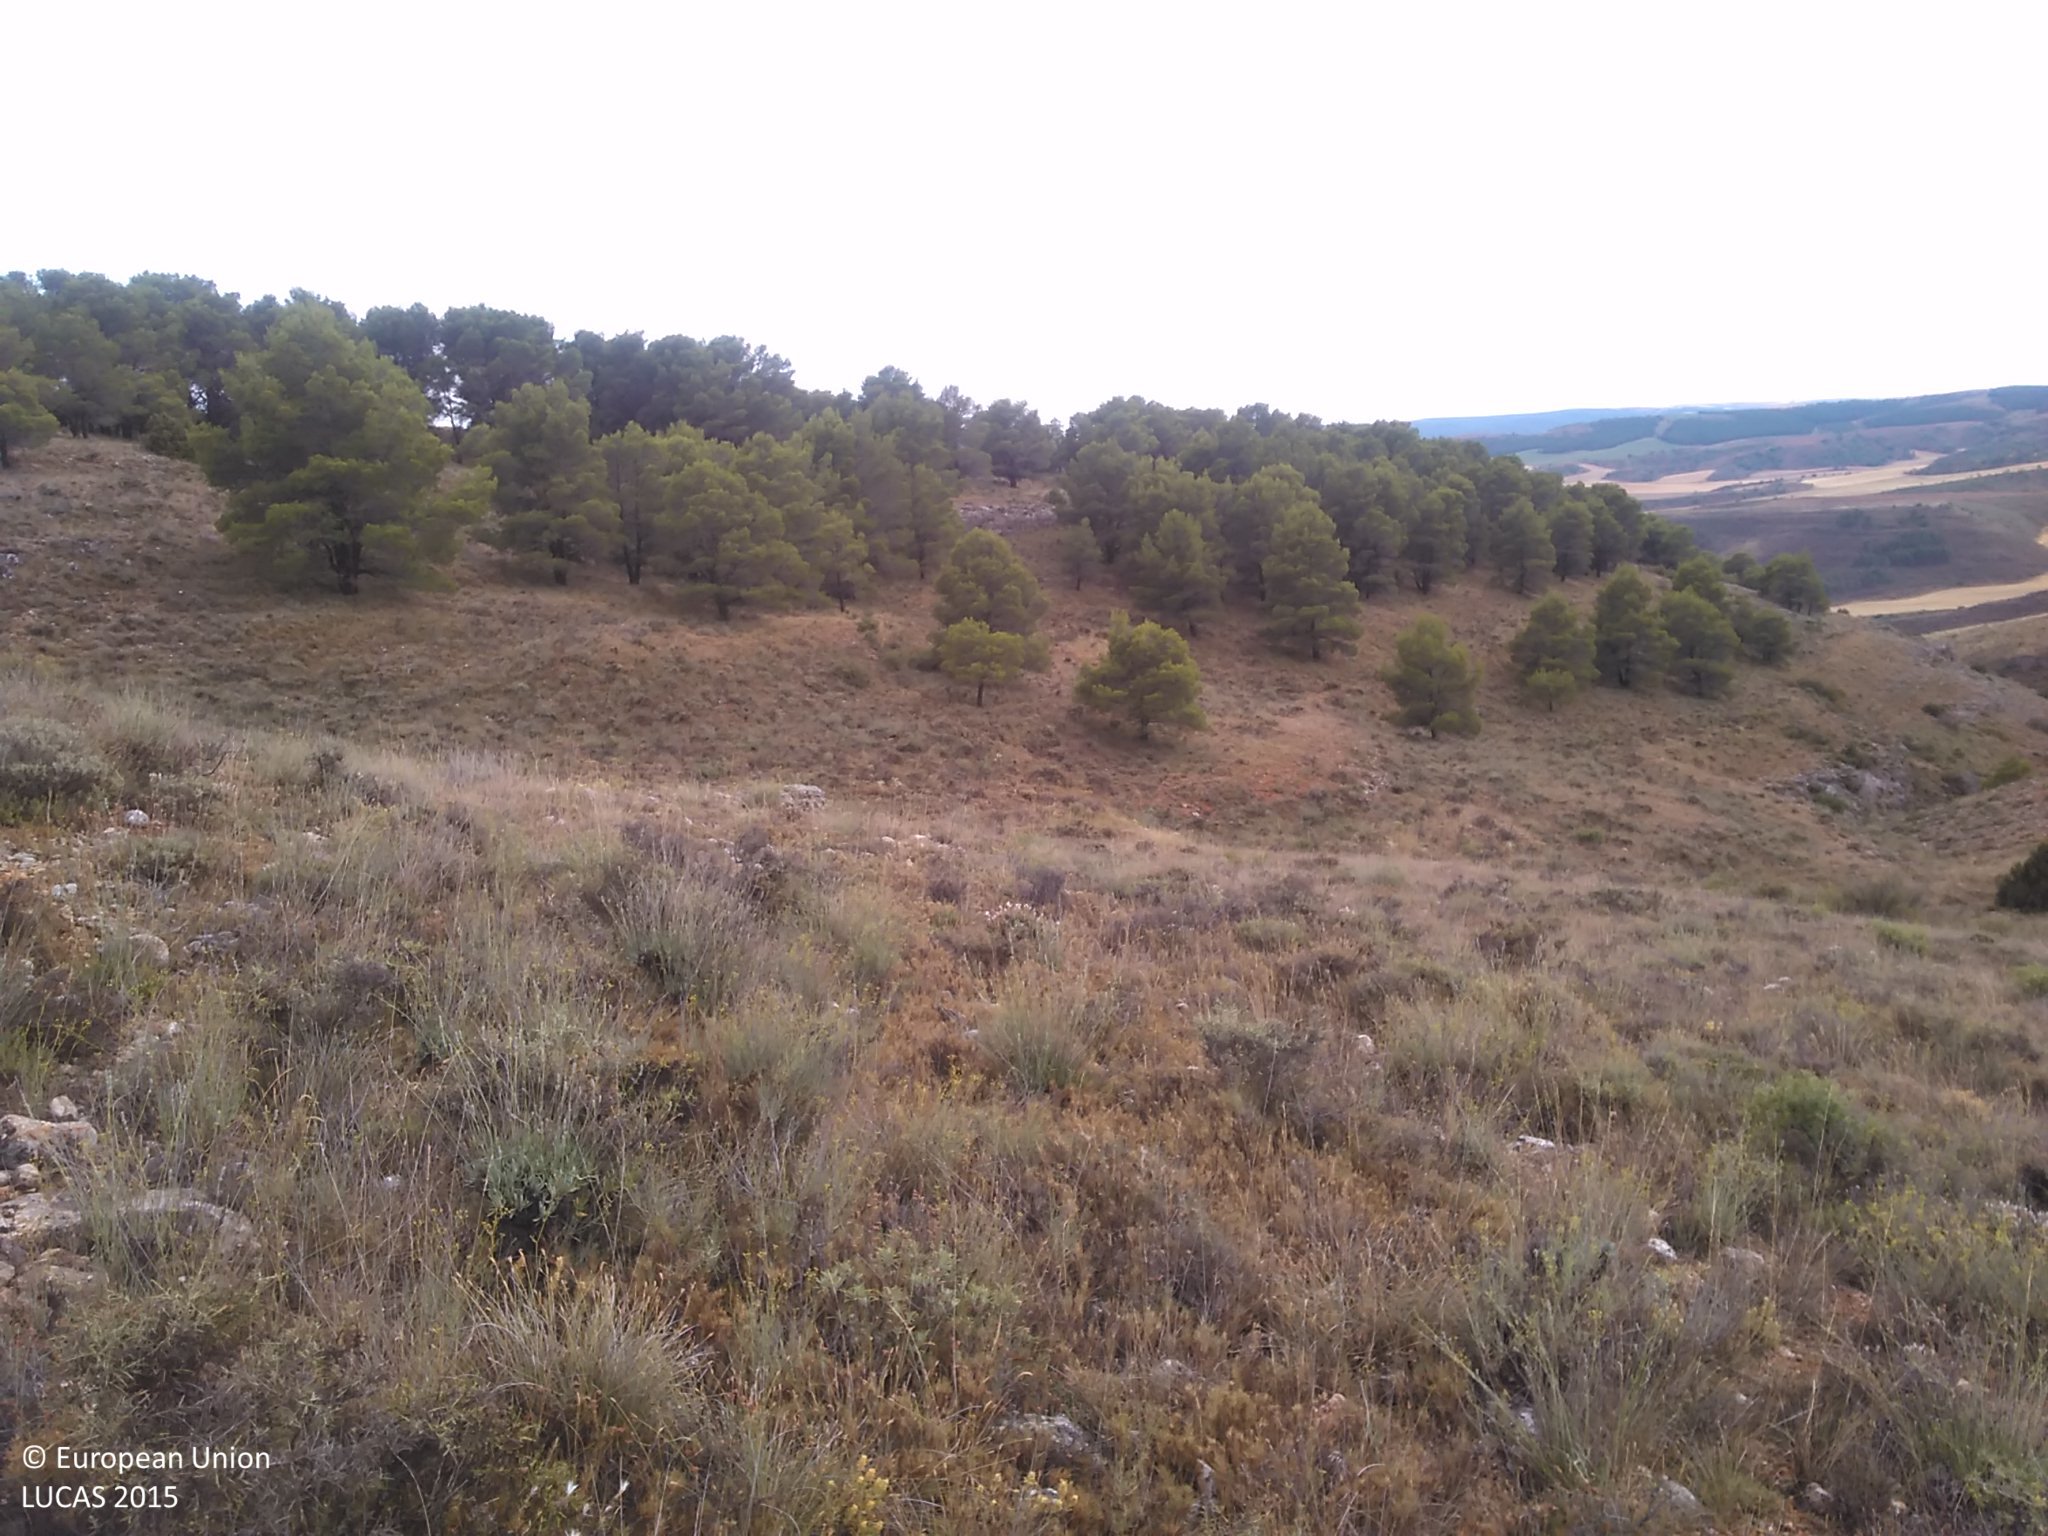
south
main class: Shrubland
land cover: Shrubland without tree cover
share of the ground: 50 - 75 %
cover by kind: shrubs 60 %, herbaceous plants 20 %, unconsolidated bare surface 20 %
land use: Semi-natural and natural areas not in use
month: July
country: ES
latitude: 41.4440
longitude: -2.0109
